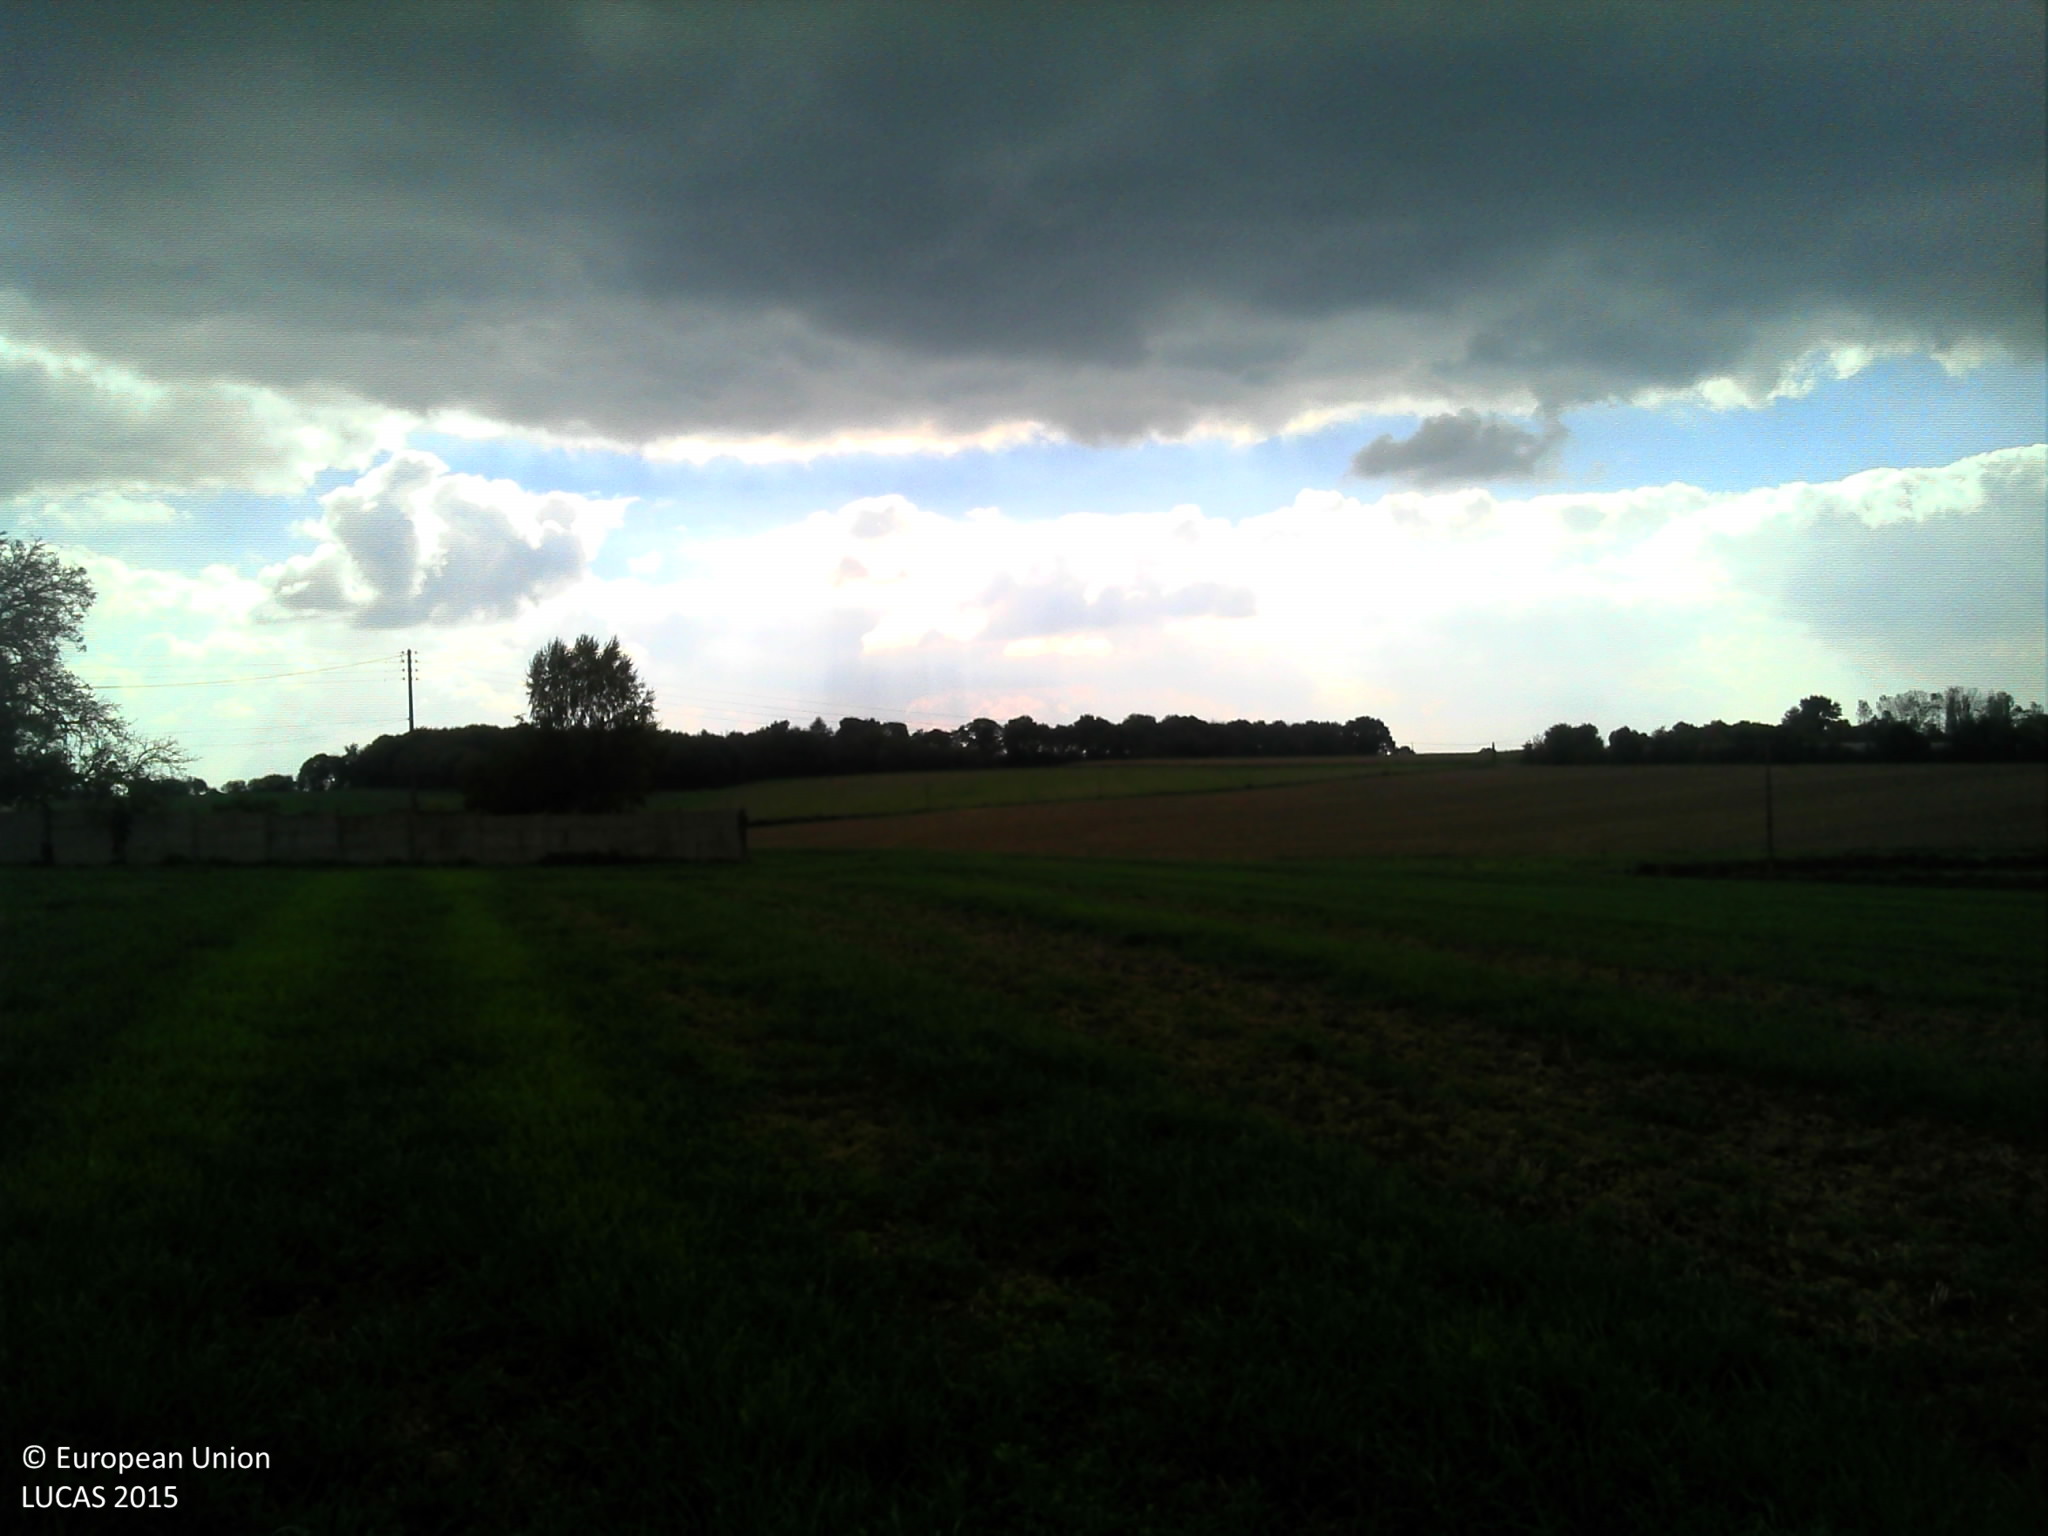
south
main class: Cropland
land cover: Temporary grasslands
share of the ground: > 75 %
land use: Agriculture (excluding fallow land and kitchen gardens)
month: October
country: FR
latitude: 47.2244
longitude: -0.9299
